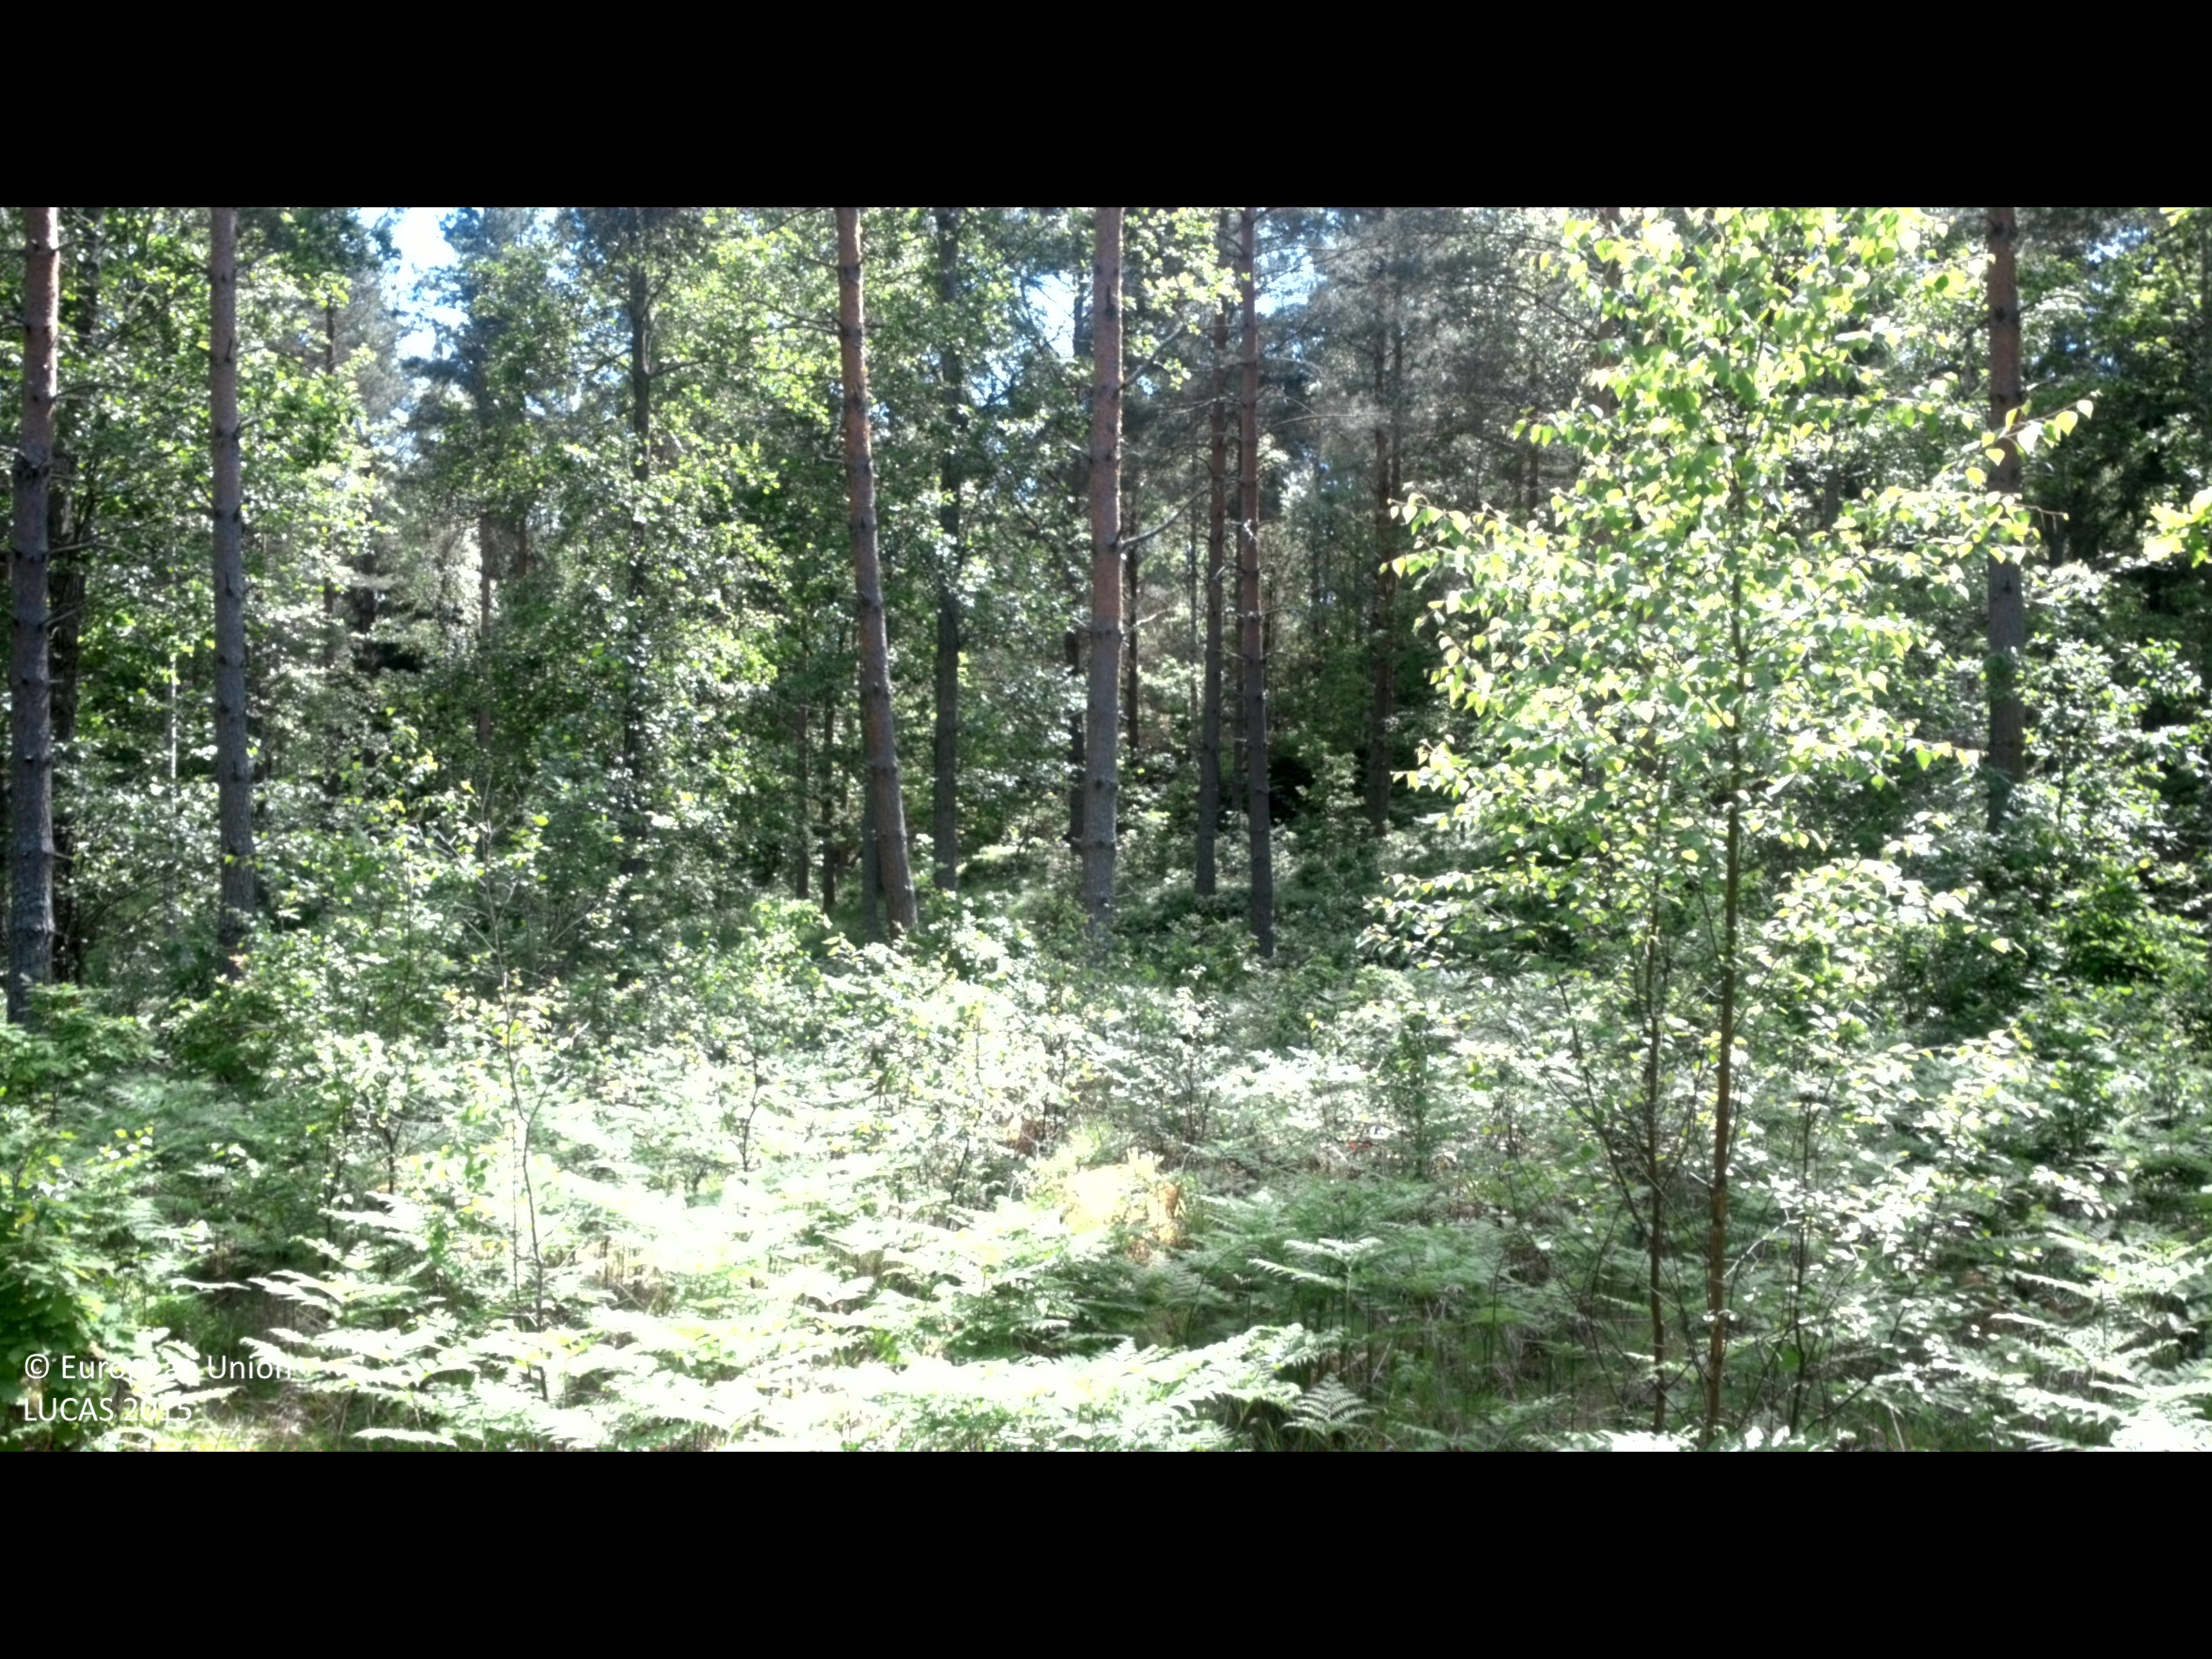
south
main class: Woodland
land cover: Pine dominated mixed woodland
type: boreal forest
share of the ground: 50 - 75 %
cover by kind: coniferous forest trees 45 %, broadleaved forest trees 20 %, herbaceous plants 15 %, shrubs 10 %, lichens and mosses 10 %
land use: Forestry
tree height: > 5 m
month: June
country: SE
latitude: 57.6072
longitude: 16.5765
